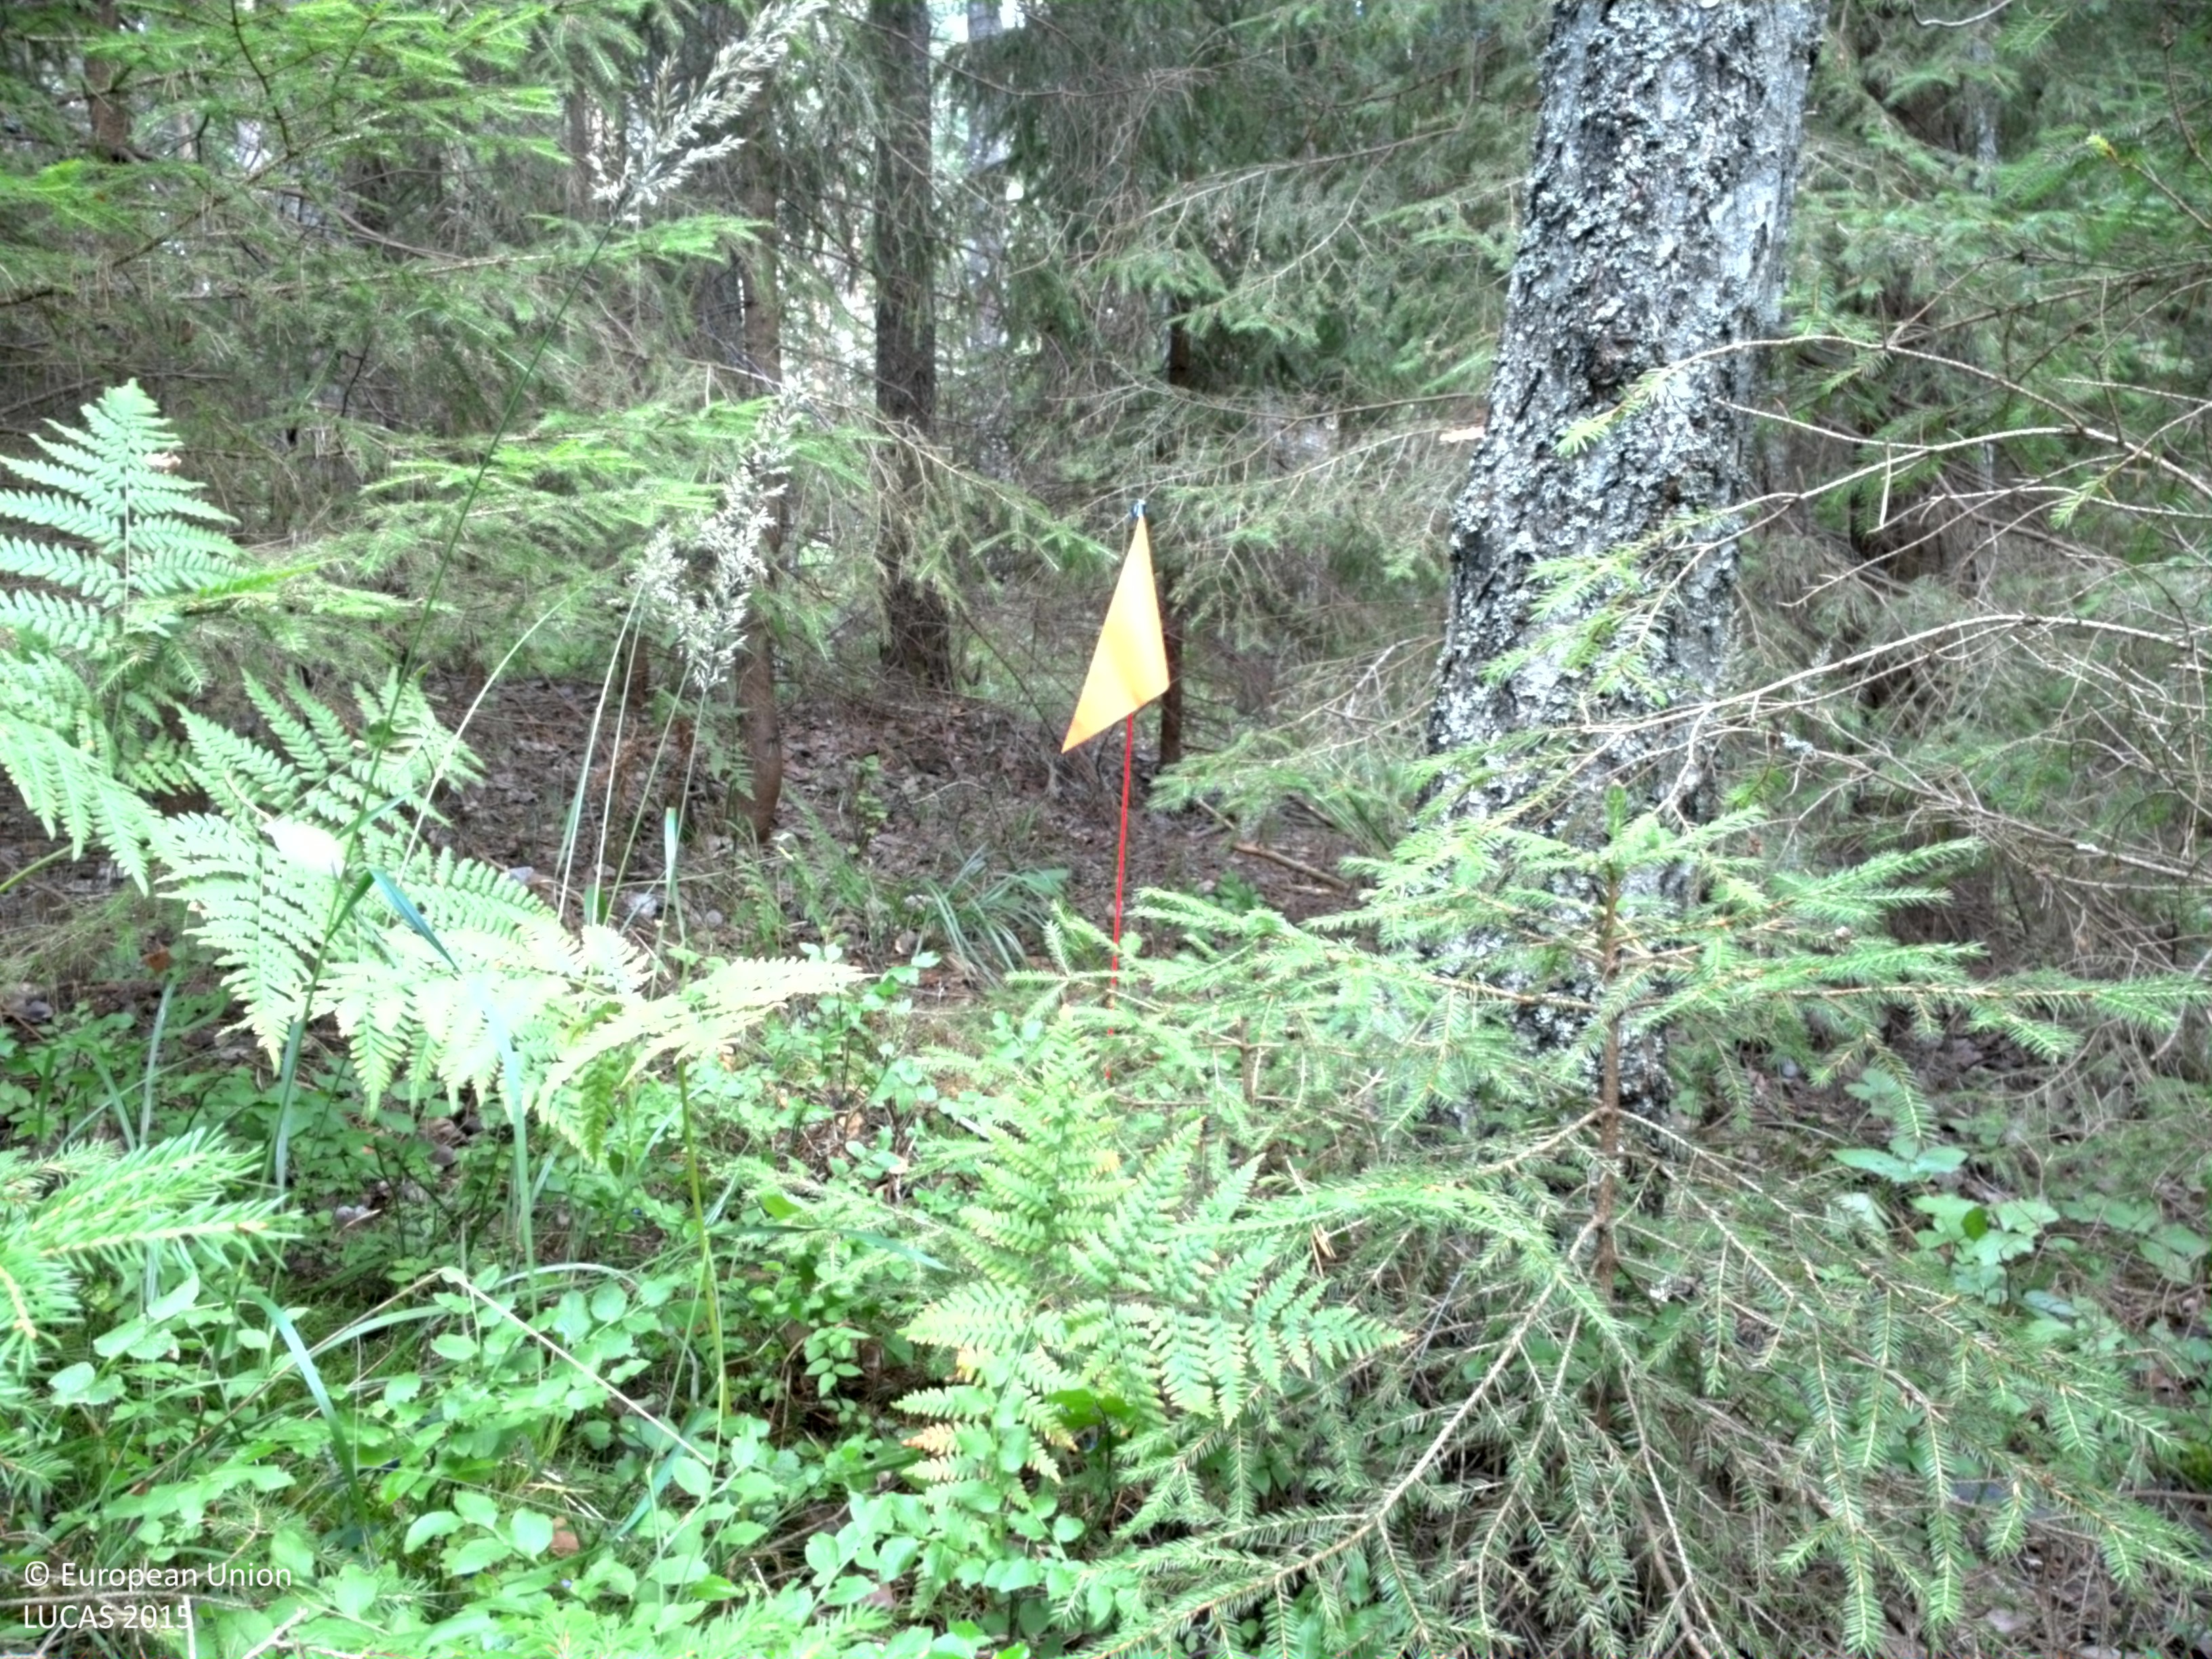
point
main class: Woodland
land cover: Spruce dominated coniferous woodland
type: boreal forest
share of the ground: > 75 %
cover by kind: coniferous forest trees 75 %, shrubs 10 %, lichens and mosses 10 %, broadleaved forest trees 5 %
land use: Forestry
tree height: > 5 m
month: July
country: SE
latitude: 59.4852
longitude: 18.5640
